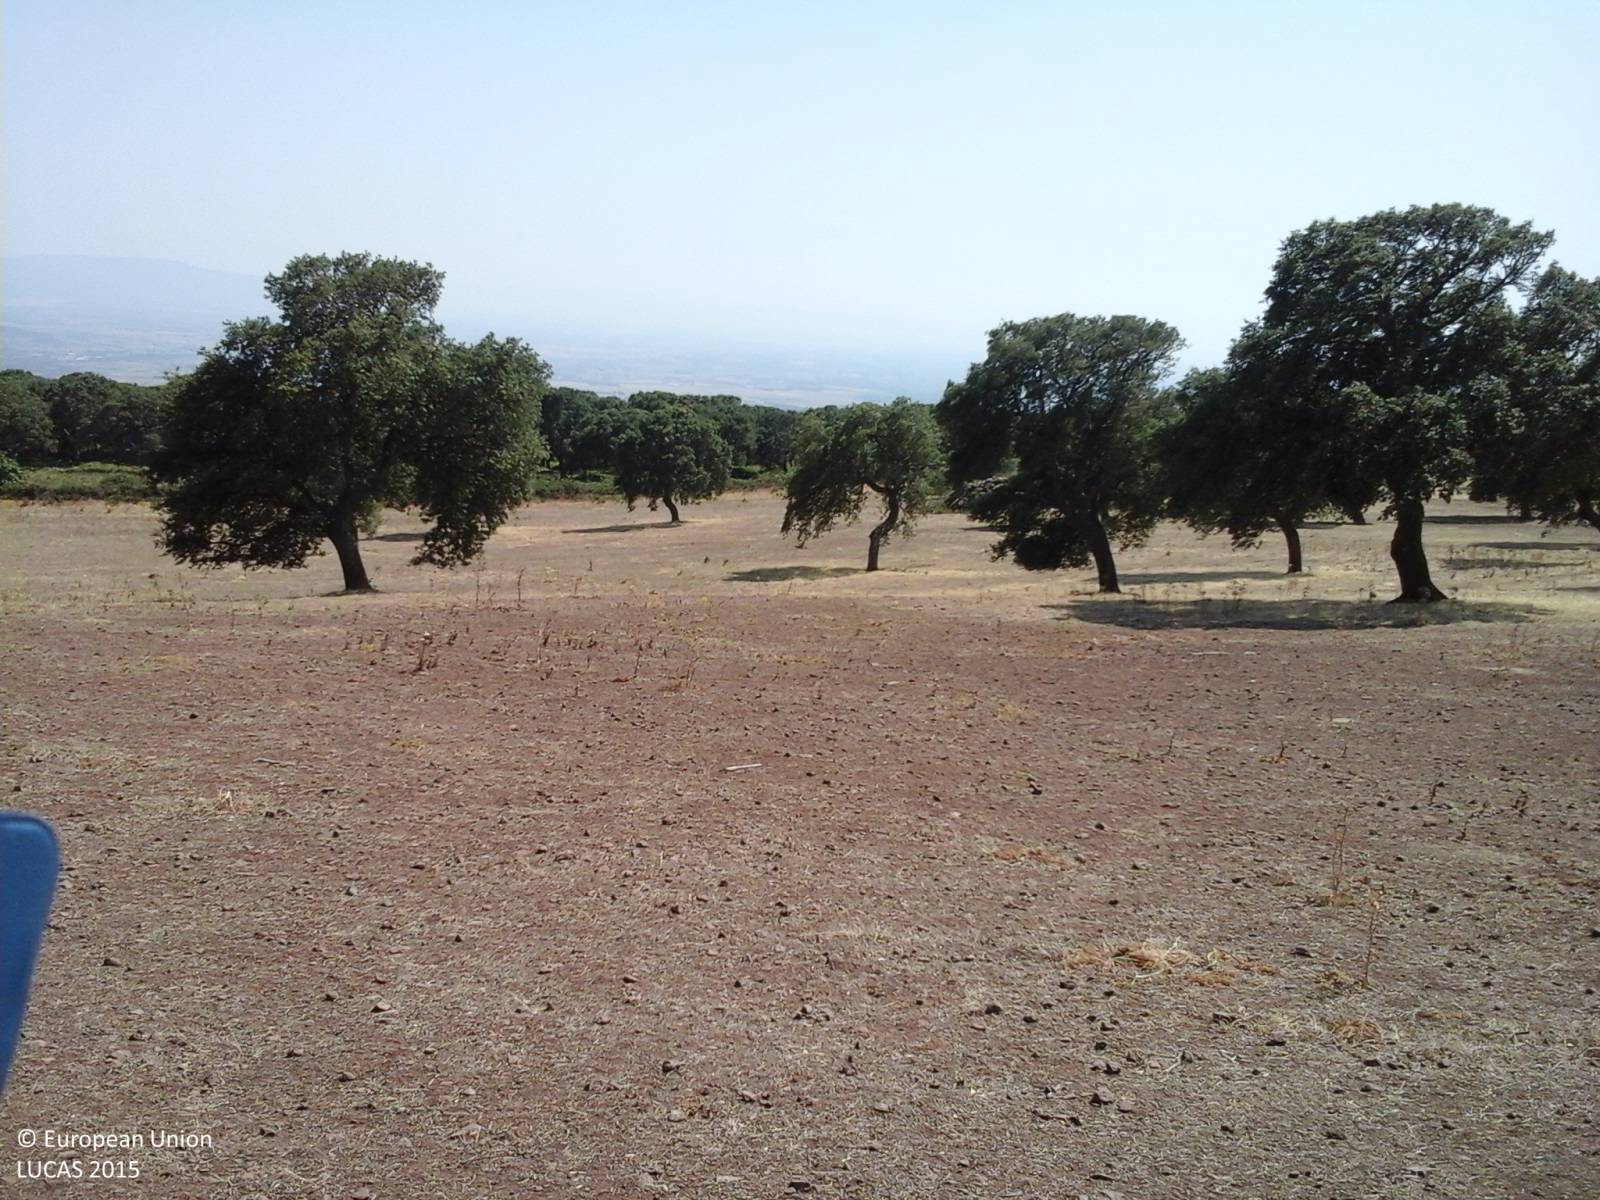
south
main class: Grassland
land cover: Grassland without tree/shrub cover
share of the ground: > 75 %
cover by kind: herbaceous plants 100 %
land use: Agriculture (excluding fallow land and kitchen gardens)
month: July
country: IT
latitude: 40.1130
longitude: 8.6346
